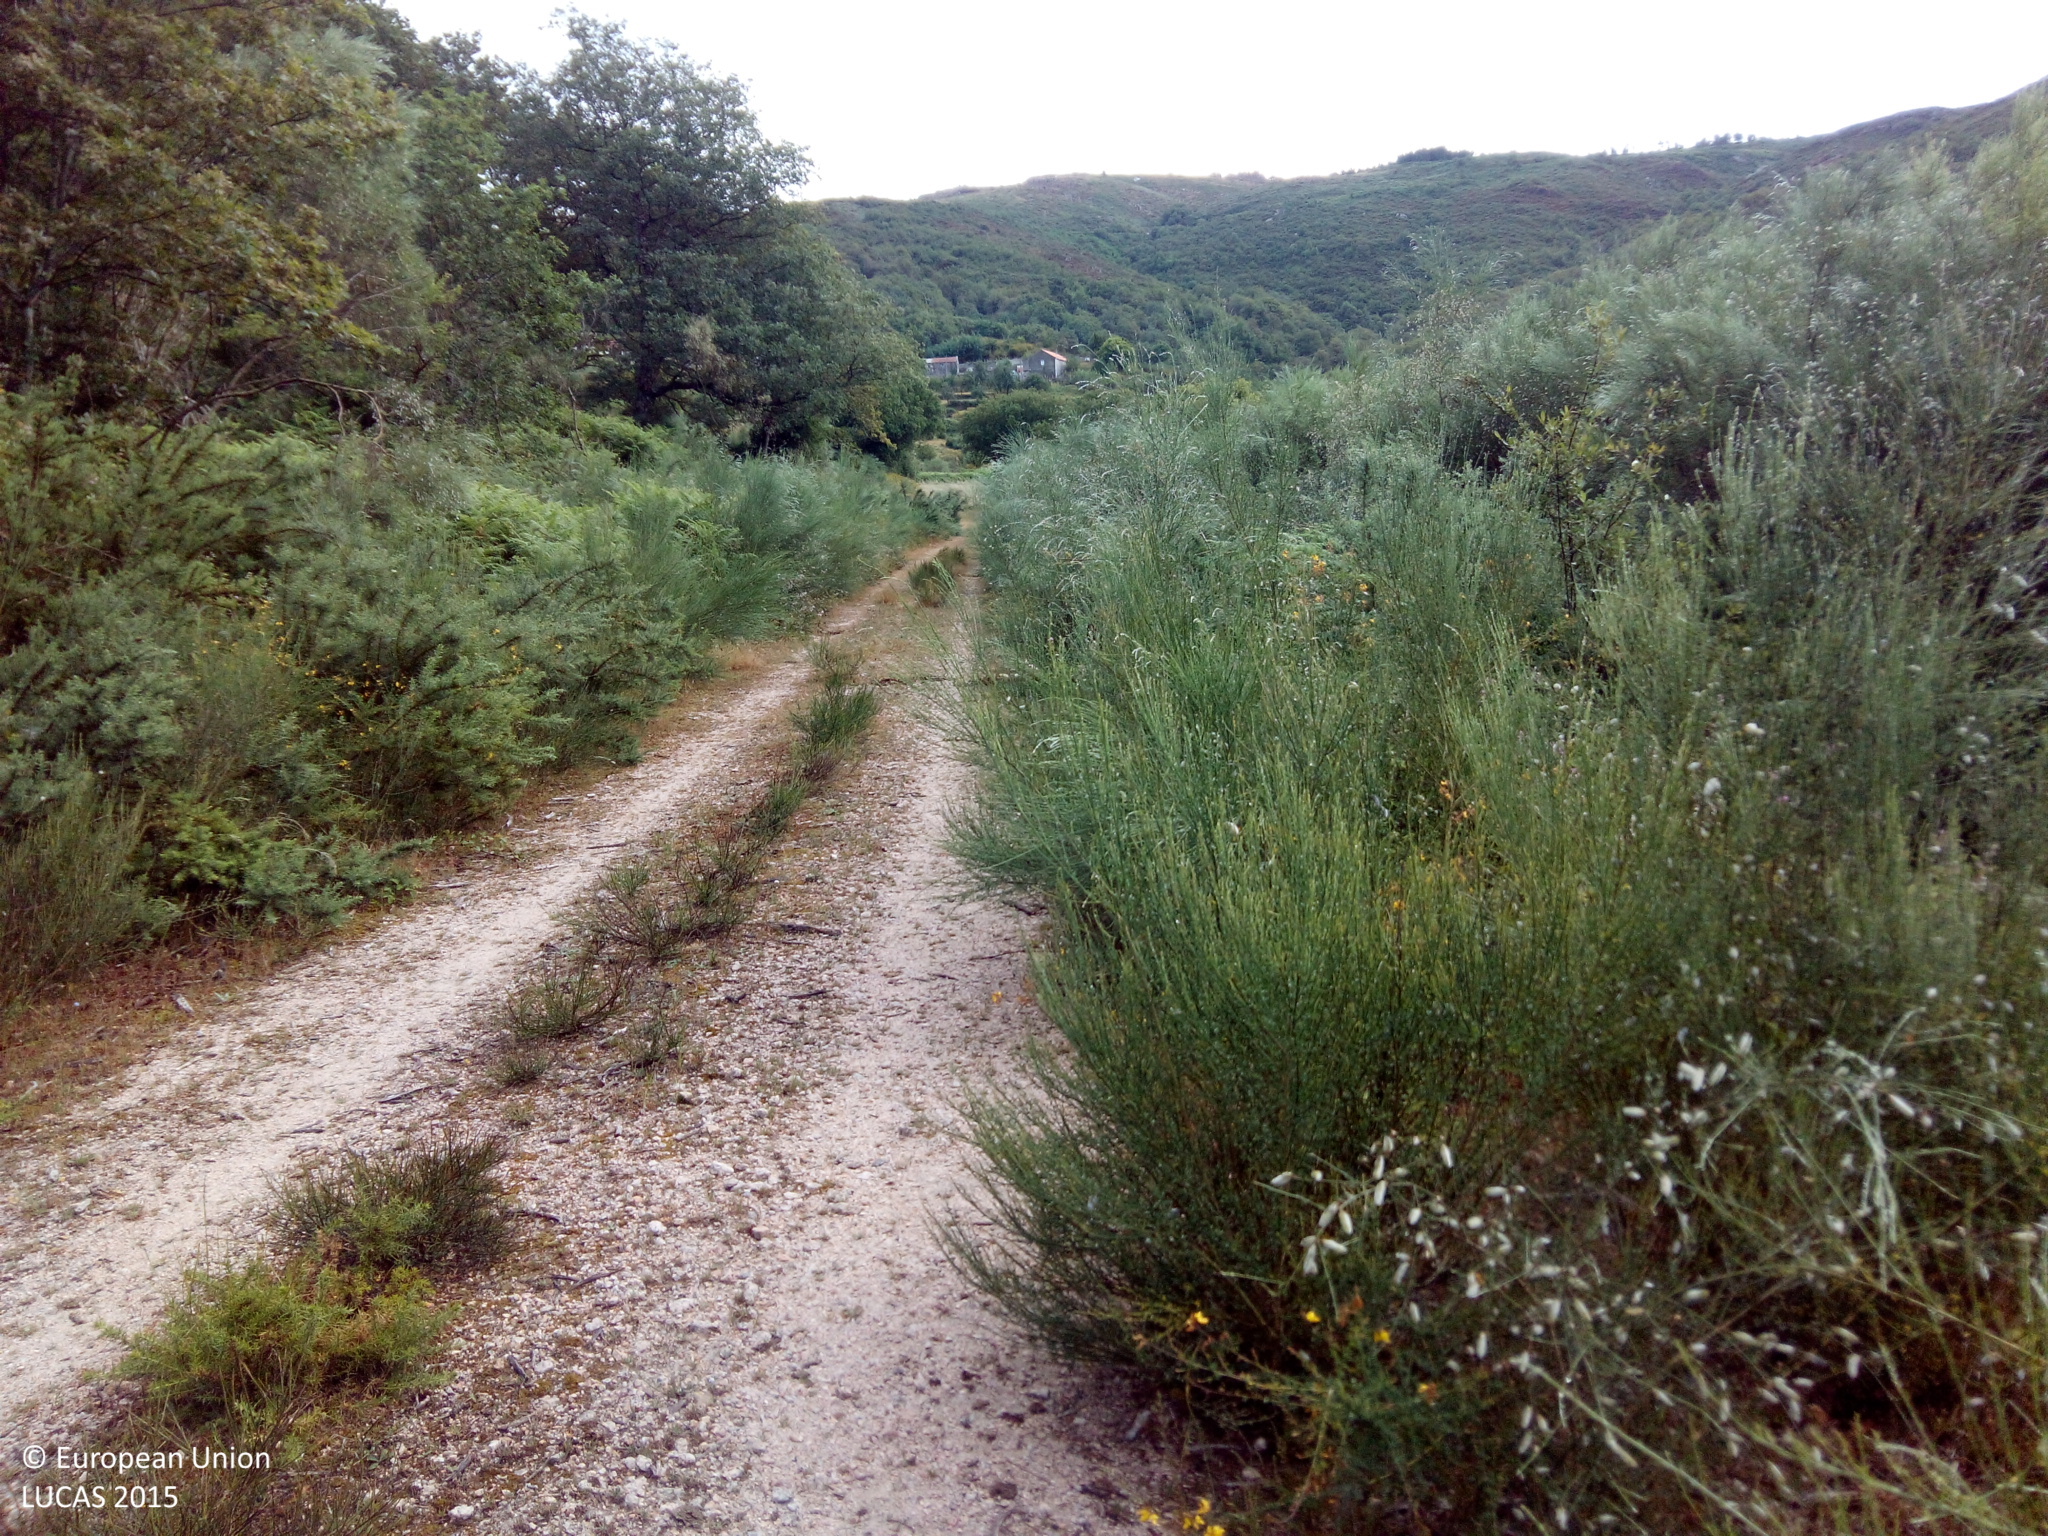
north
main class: Woodland
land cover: Broadleaved woodland
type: broadleaved evergreen forest
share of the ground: > 75 %
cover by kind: broadleaved forest trees 100 %
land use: Semi-natural and natural areas not in use
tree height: > 5 m
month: July
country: ES
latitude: 42.3004
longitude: -8.2963
